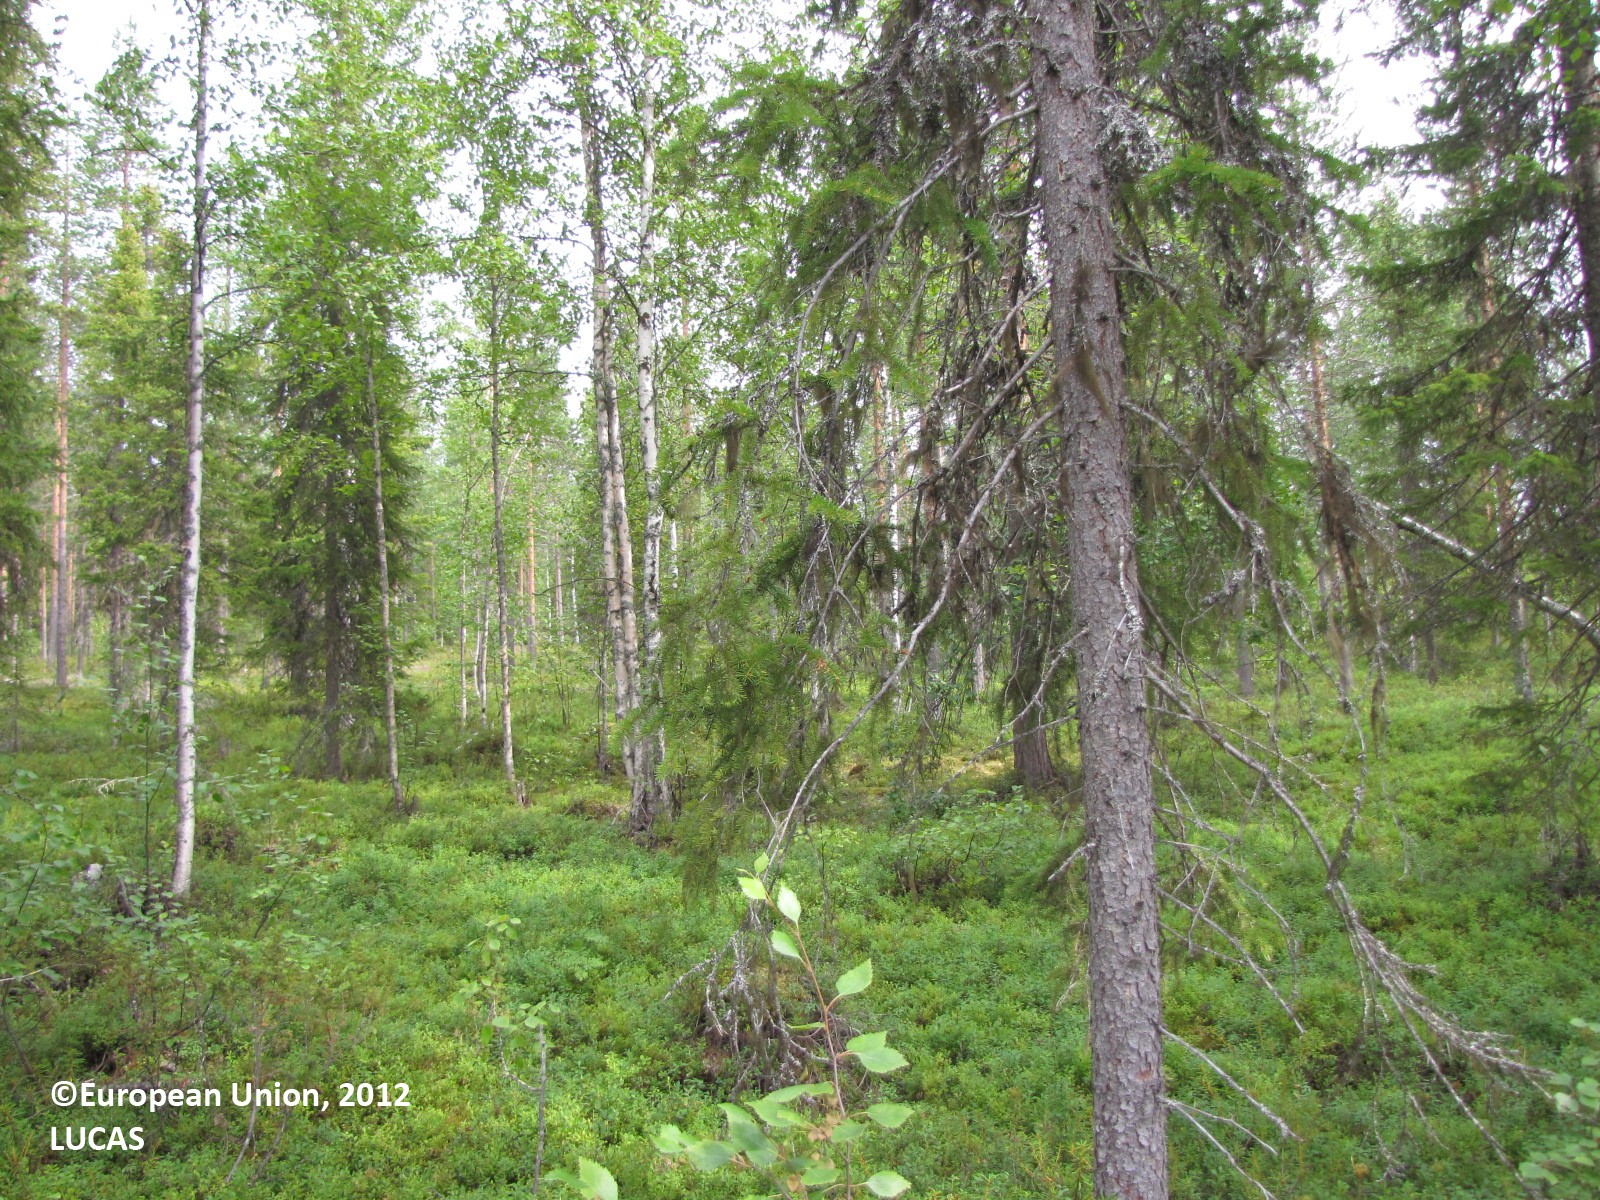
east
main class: Woodland
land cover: Other mixed woodland
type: boreal forest
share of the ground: 10 - 25 %
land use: Forestry
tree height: > 5 m
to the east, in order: Other mixed woodland; Pine dominated mixed woodland; Tracks; Pine dominated mixed woodland; Tracks; Pine dominated mixed woodland
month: August
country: FI
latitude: 66.8508
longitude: 24.8863
